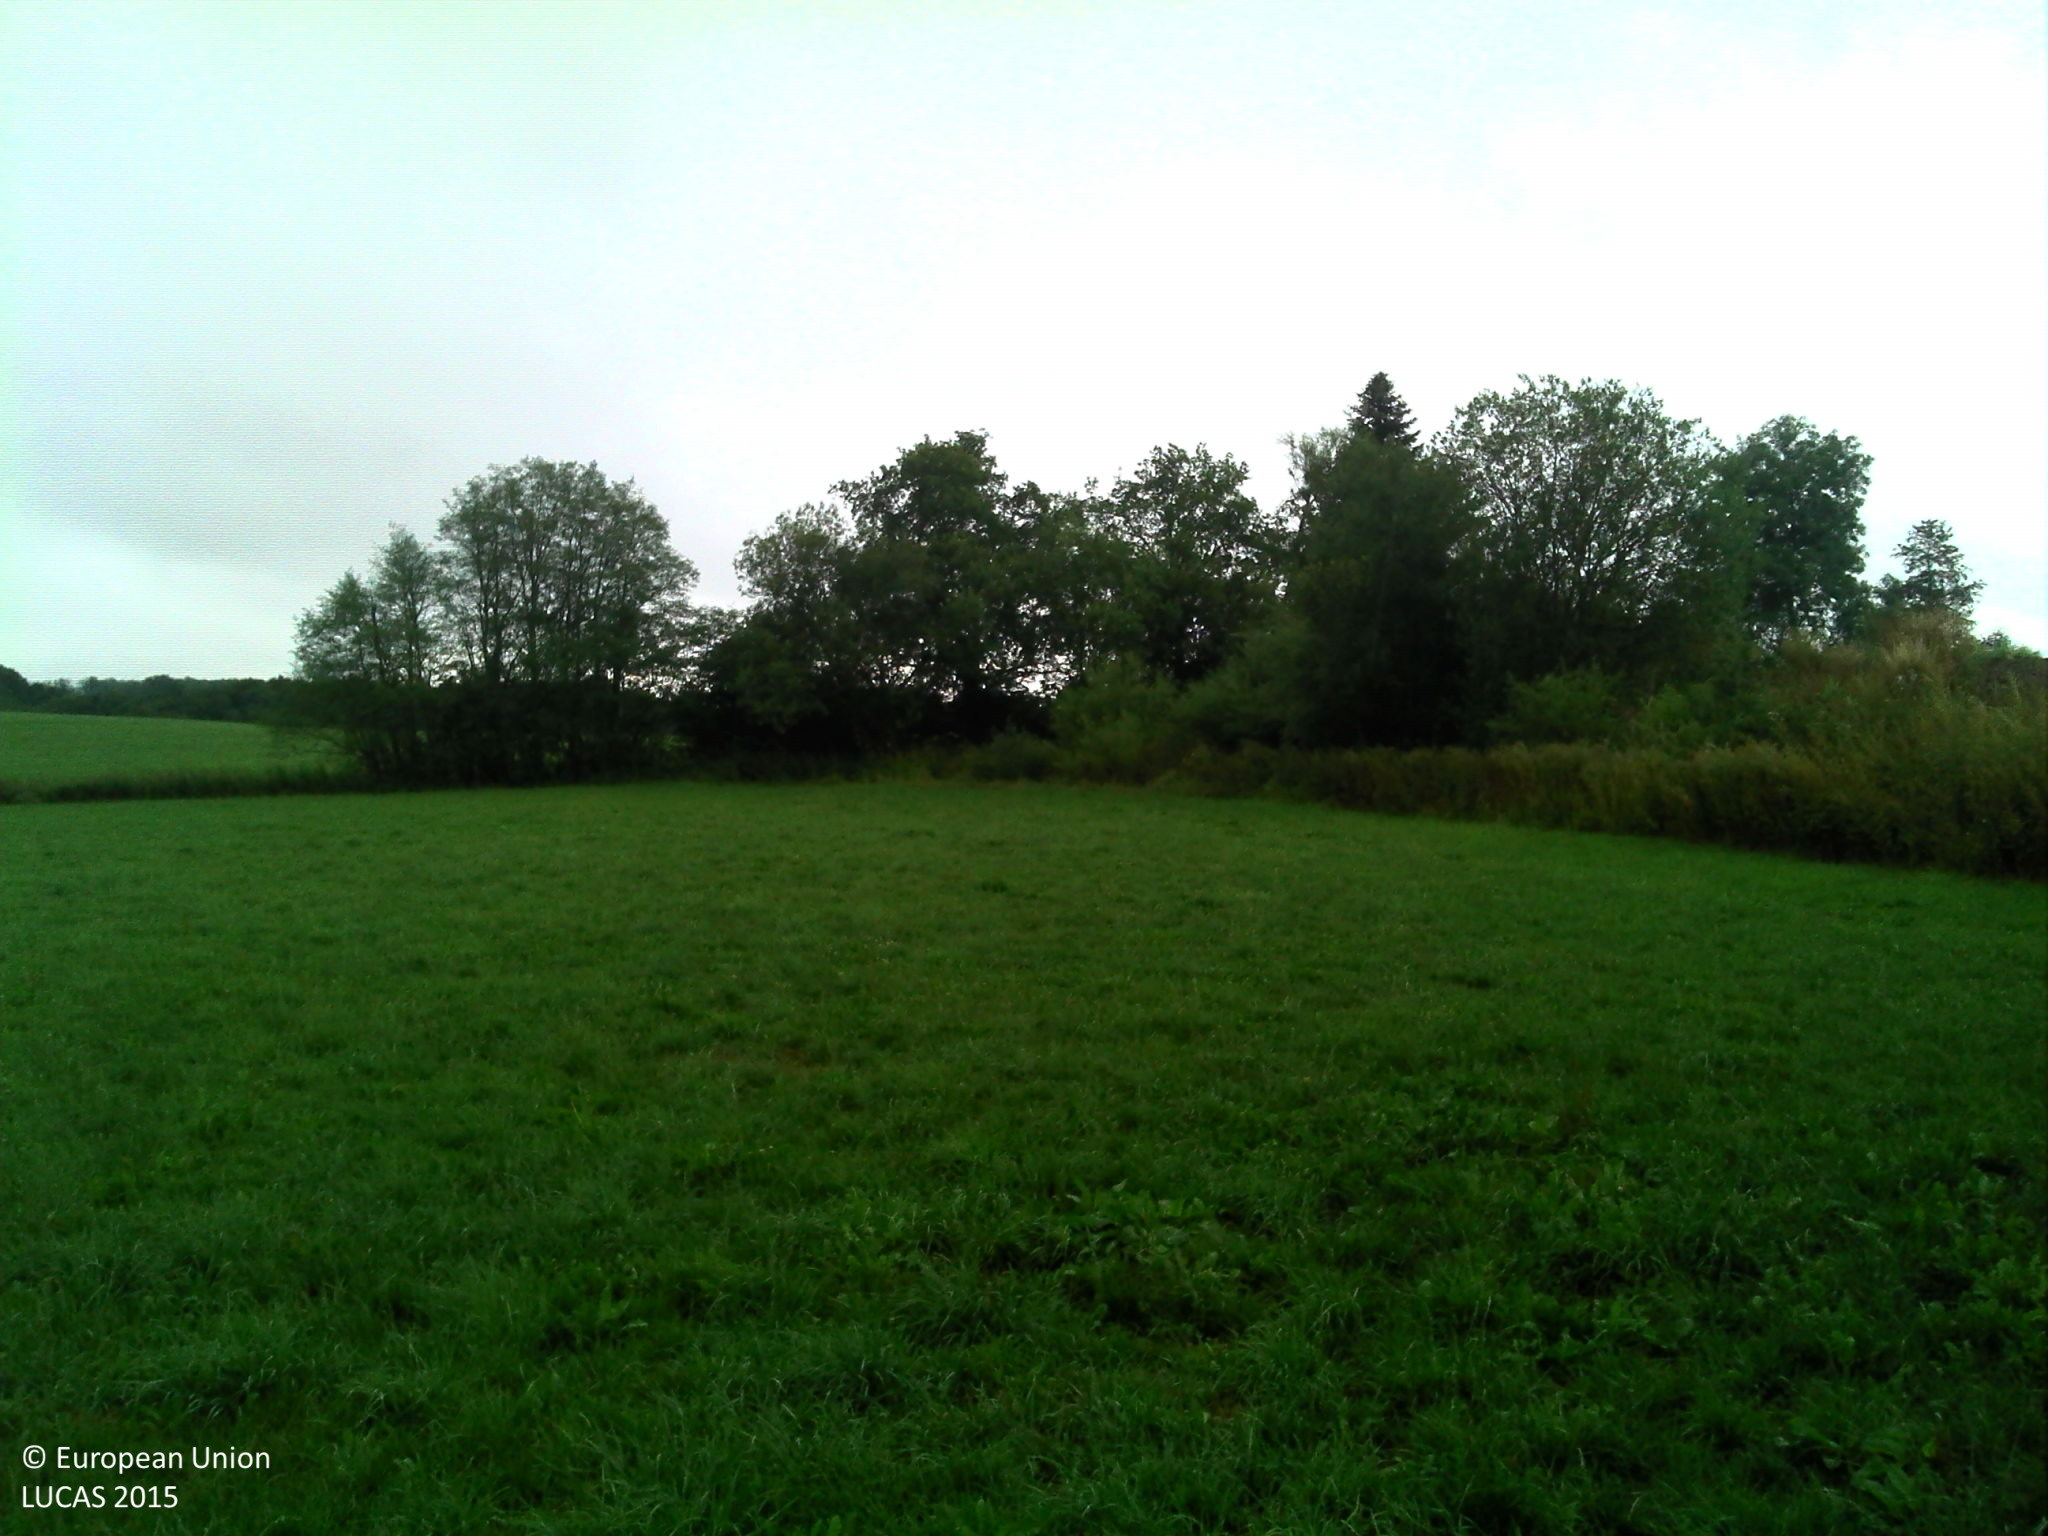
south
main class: Grassland
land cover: Grassland without tree/shrub cover
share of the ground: > 75 %
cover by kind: herbaceous plants 100 %
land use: Agriculture (excluding fallow land and kitchen gardens)
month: July
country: FR
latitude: 46.0490
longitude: 6.1912
